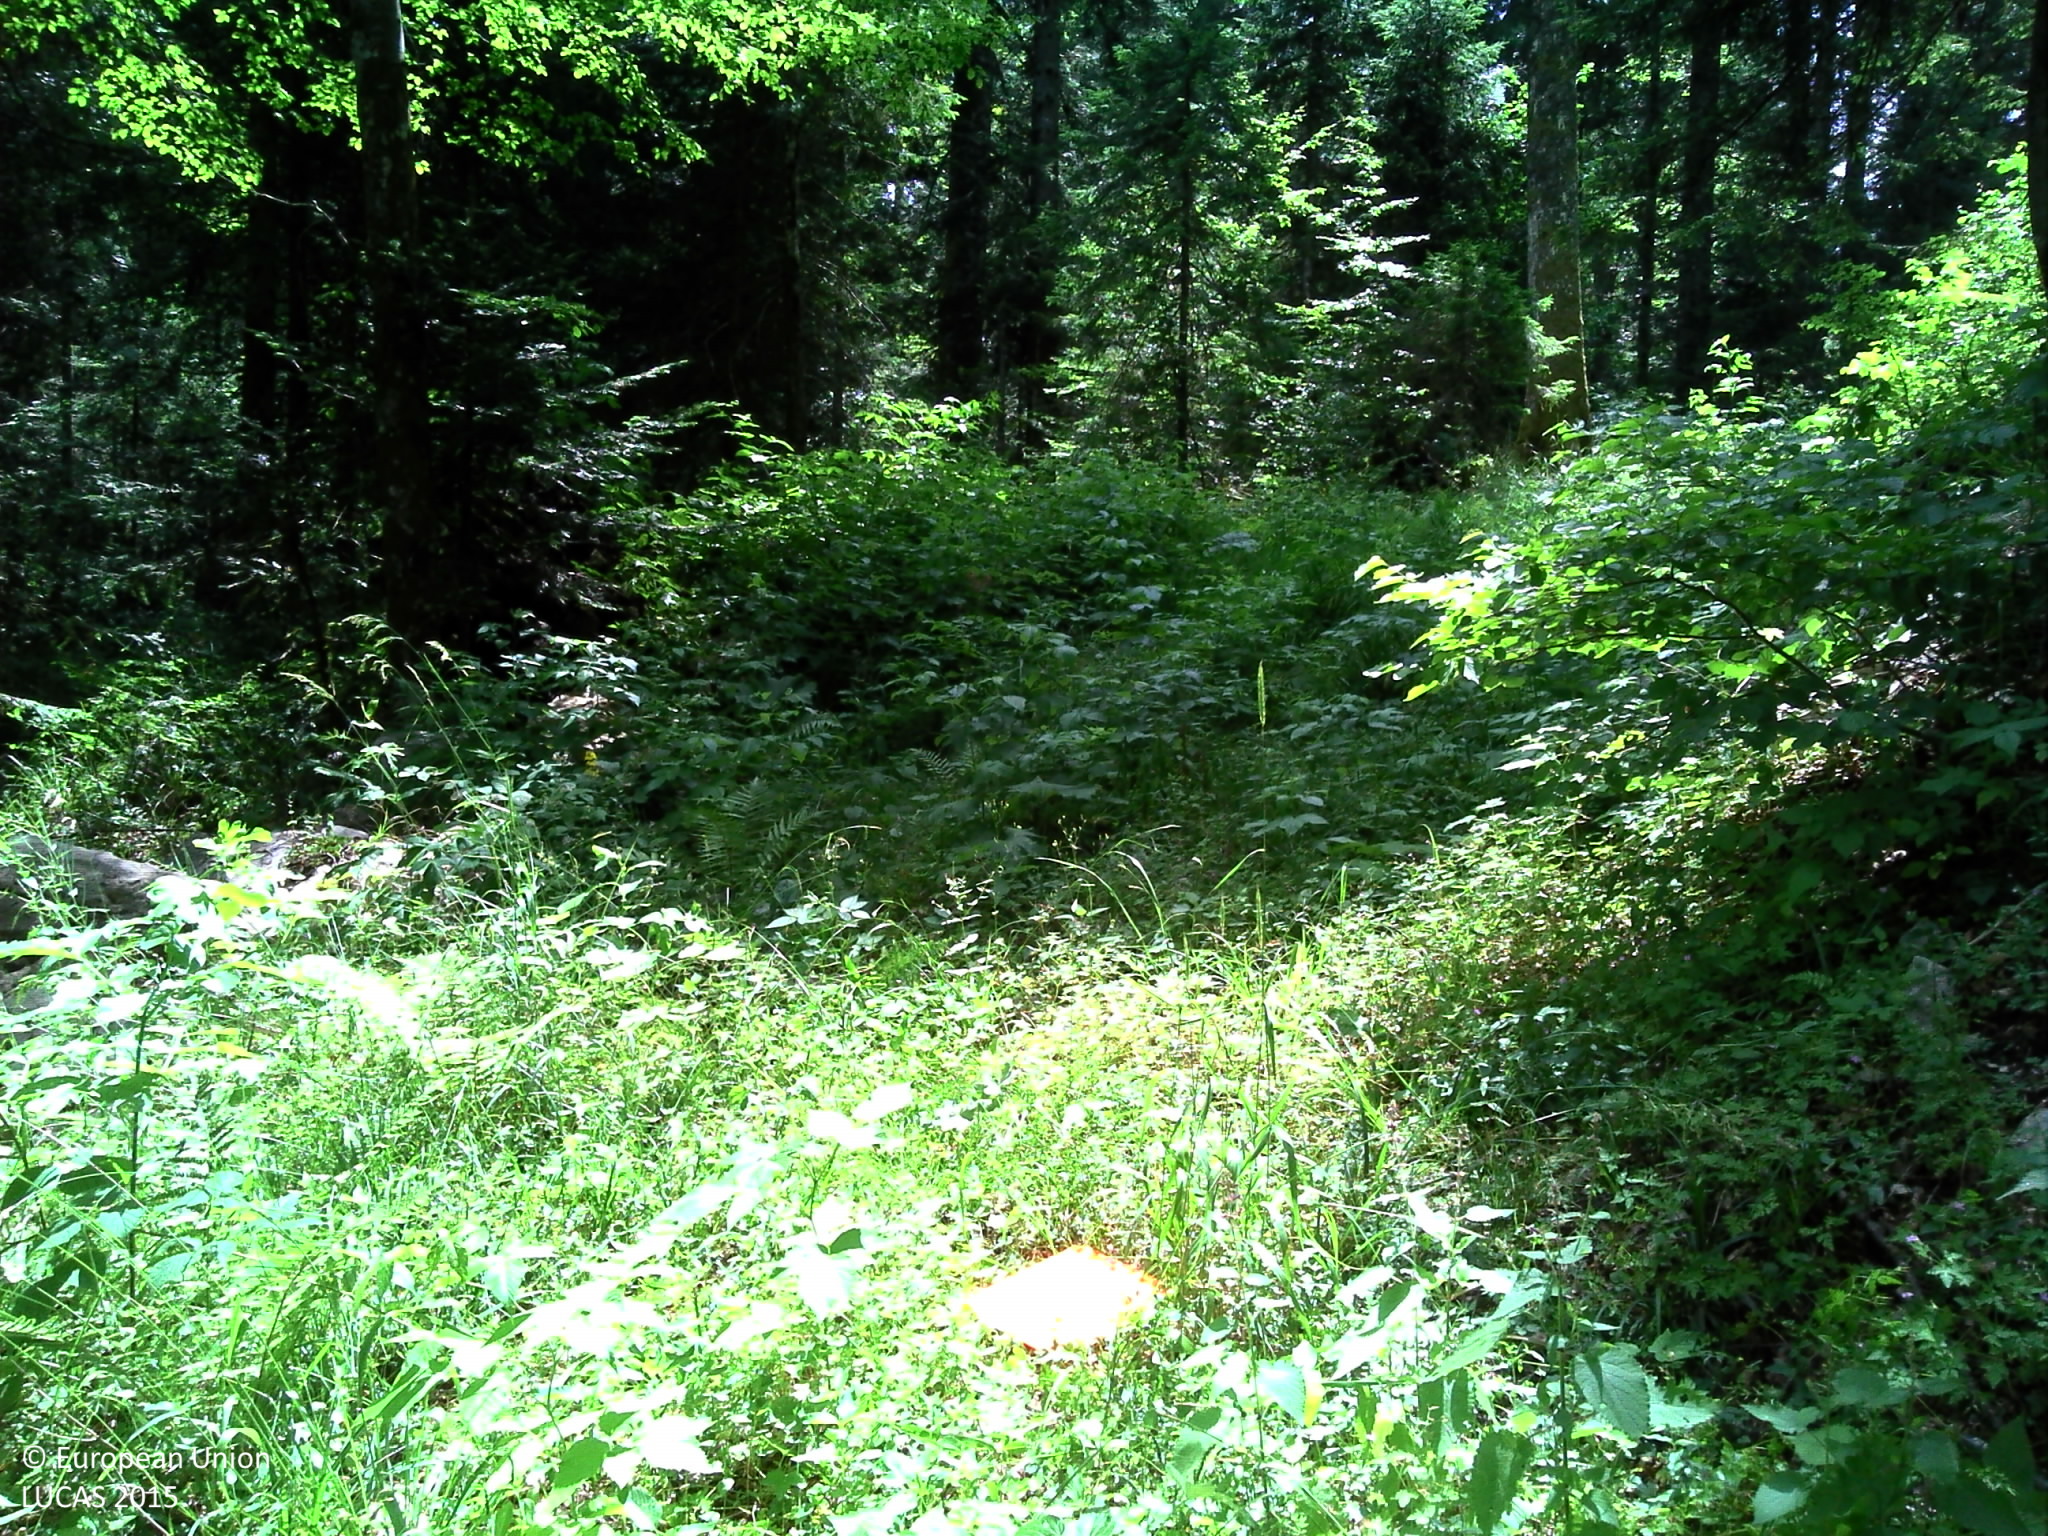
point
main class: Woodland
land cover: Spruce dominated mixed woodland
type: mountainous beech forest
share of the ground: > 75 %
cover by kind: coniferous forest trees 30 %, broadleaved forest trees 30 %, shrubs 10 %, herbaceous plants 10 %, lichens and mosses 10 %, consolidated bare surface 10 %
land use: Forestry
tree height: > 5 m
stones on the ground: > 50 %
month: July
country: FR
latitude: 46.7324
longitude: 6.1422
